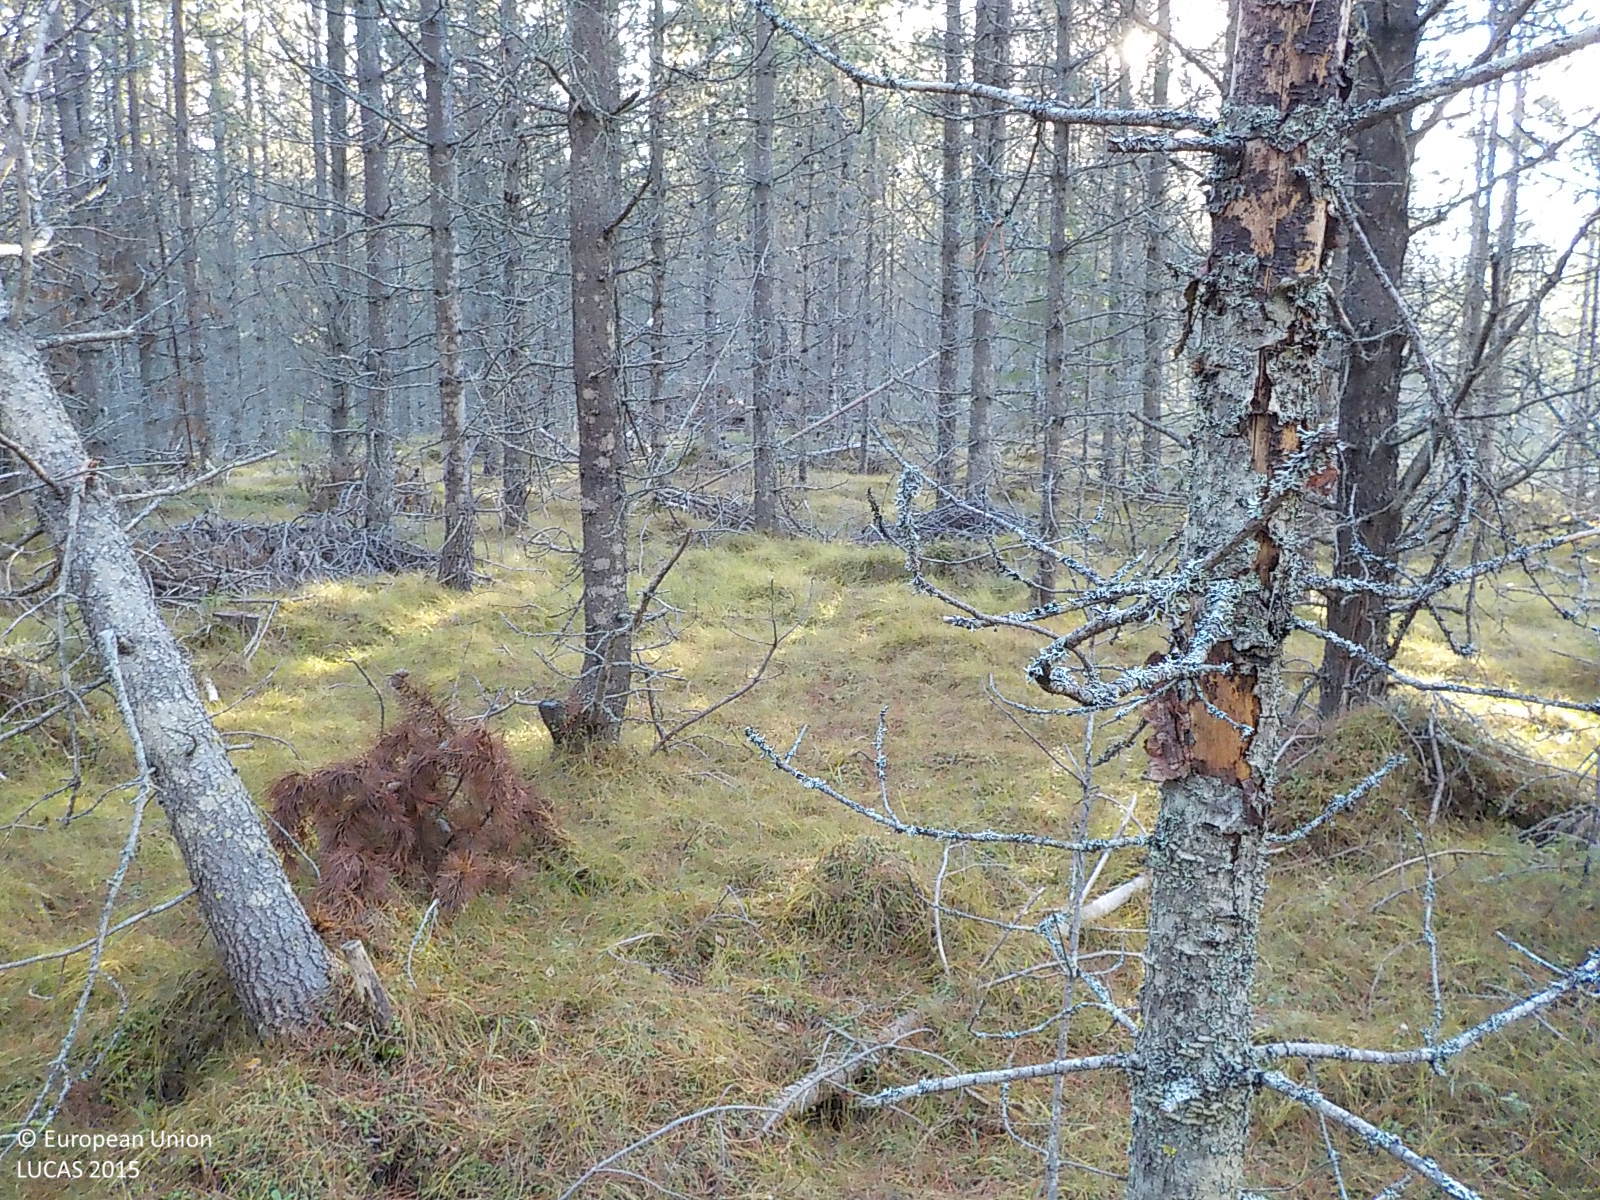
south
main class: Woodland
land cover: Other coniferous woodland
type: boreal forest
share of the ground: > 75 %
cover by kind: coniferous forest trees 75 %, shrubs 25 %
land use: Forestry
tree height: > 5 m
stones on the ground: < 10 %
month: November
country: SE
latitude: 63.2134
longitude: 16.5188
